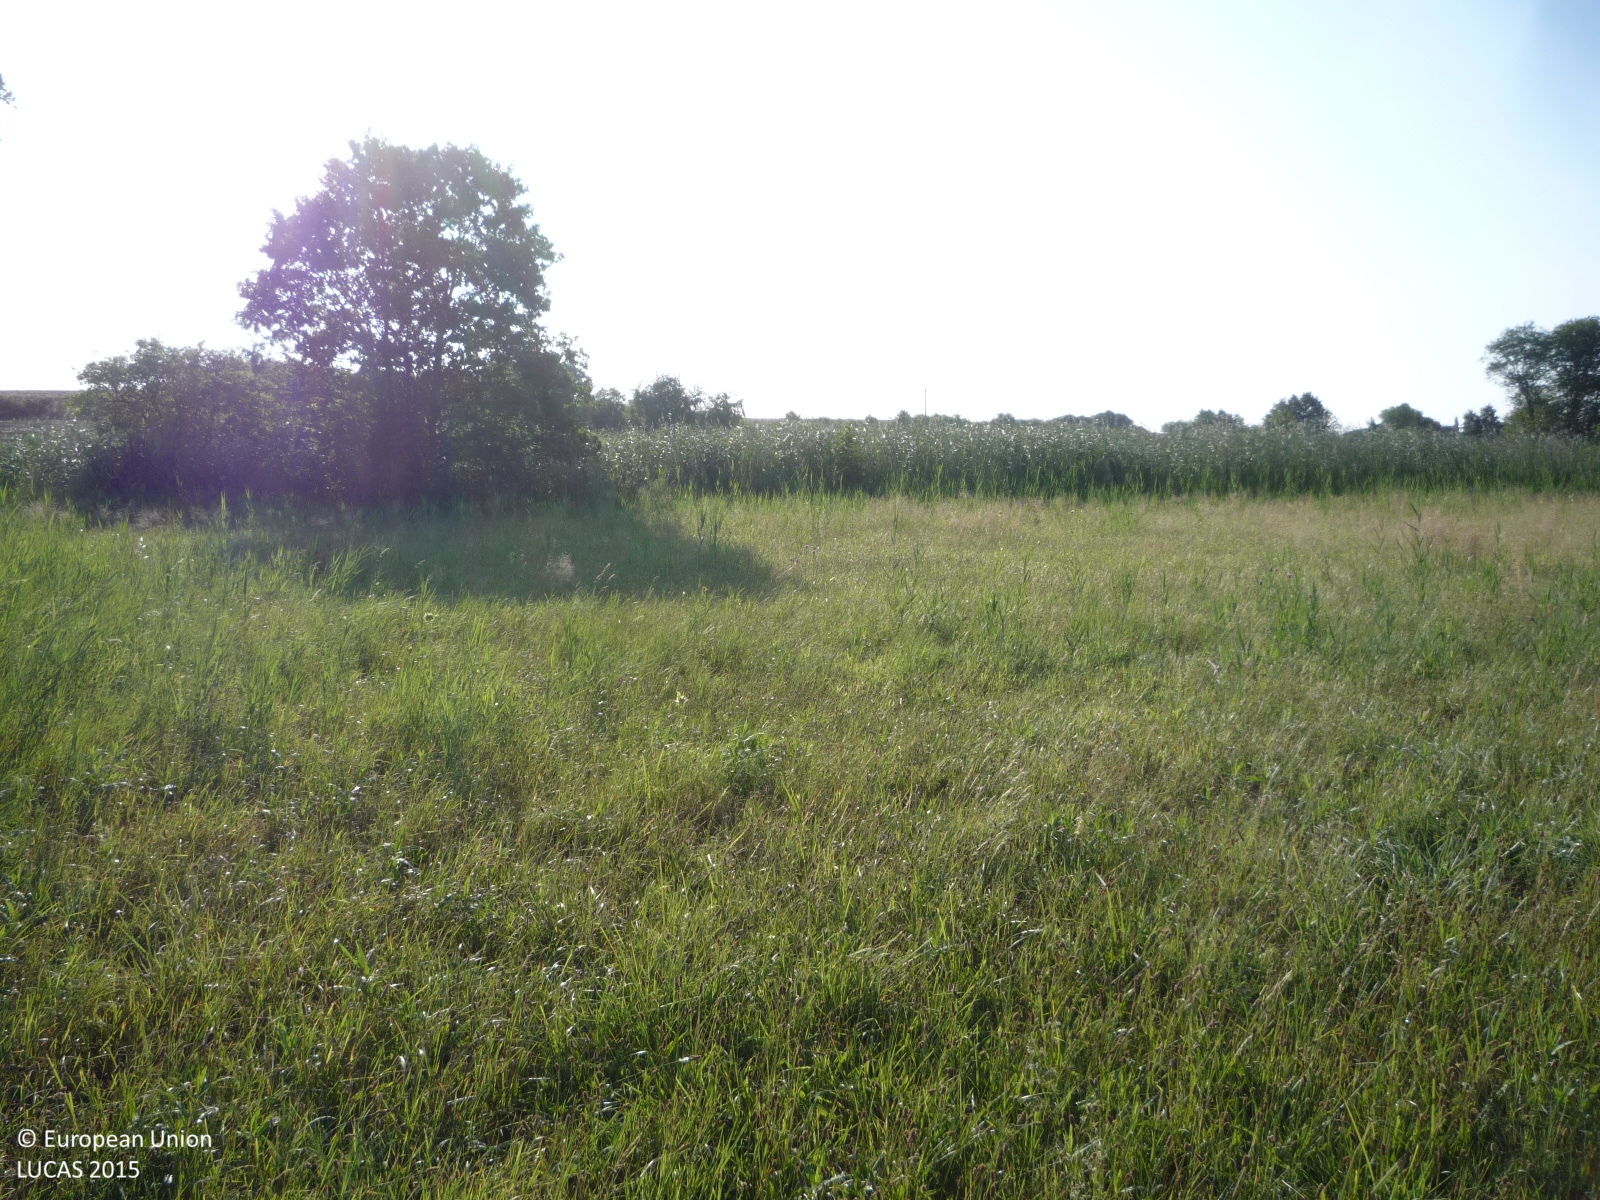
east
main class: Grassland
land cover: Grassland without tree/shrub cover
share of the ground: > 75 %
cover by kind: herbaceous plants 100 %
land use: Agriculture (excluding fallow land and kitchen gardens)
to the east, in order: Grassland without tree/shrub cover; Single bushes/trees; Spontaneously vegetated surfaces; Rape and turnip rape; Electric lines; Shrubland with sparse tree cover; Rape and turnip rape
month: July
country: CZ
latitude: 50.4402
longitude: 15.2837
